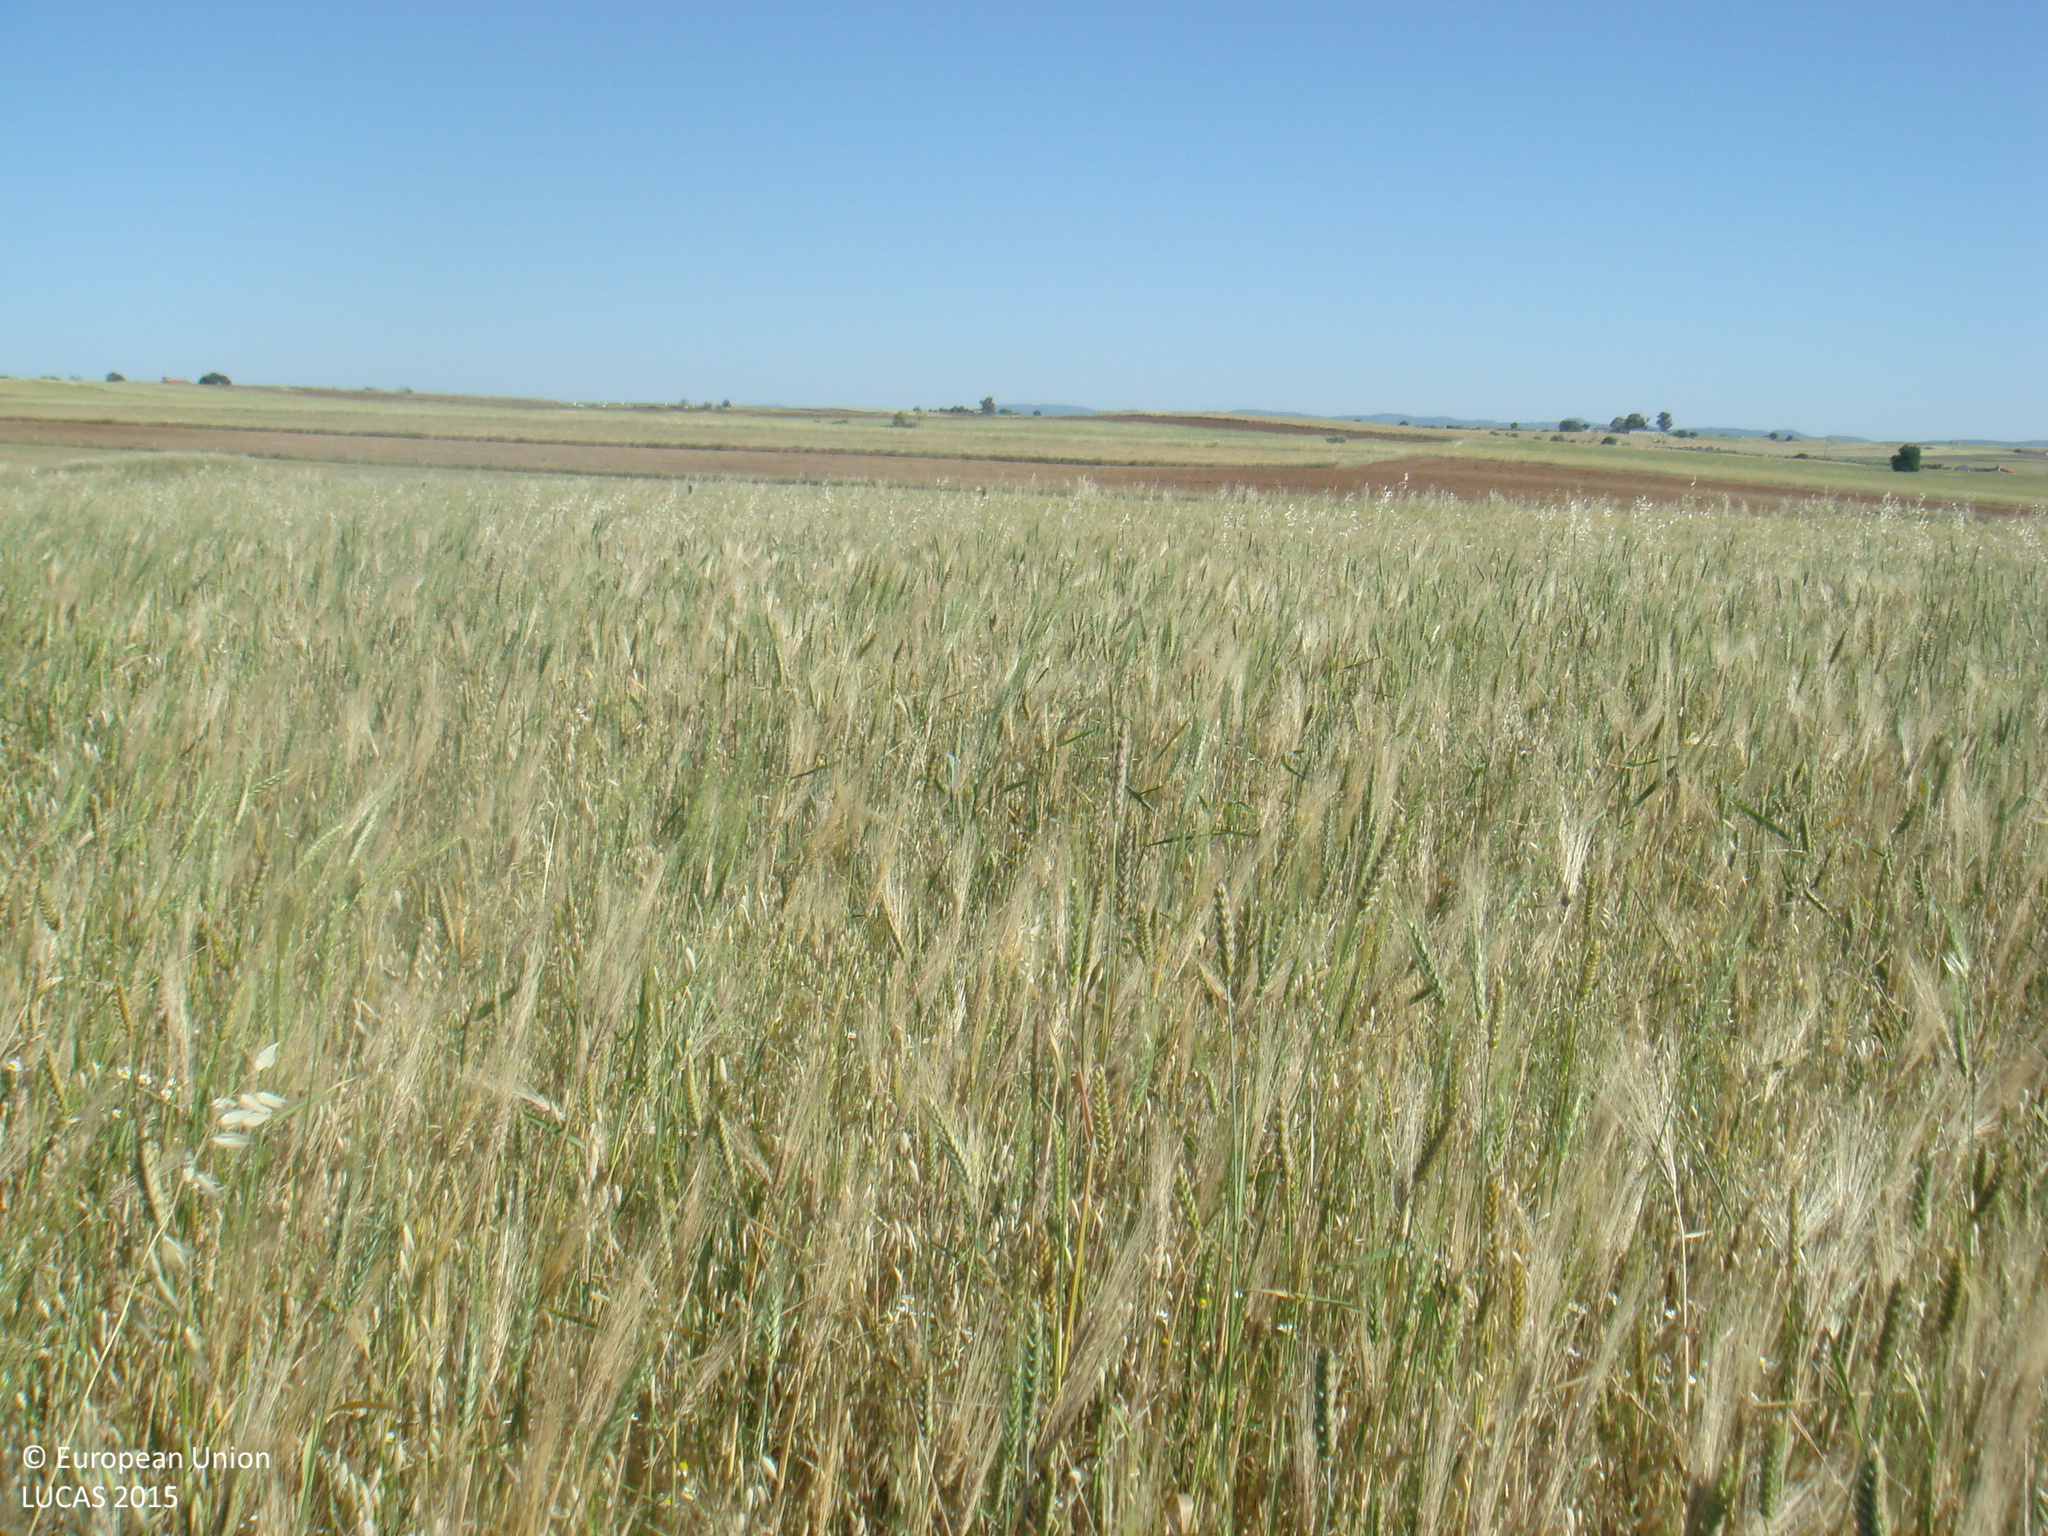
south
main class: Cropland
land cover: Mixed cereals for fodder
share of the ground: > 75 %
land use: Agriculture (excluding fallow land and kitchen gardens)
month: May
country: ES
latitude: 38.5372
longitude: -5.1160
